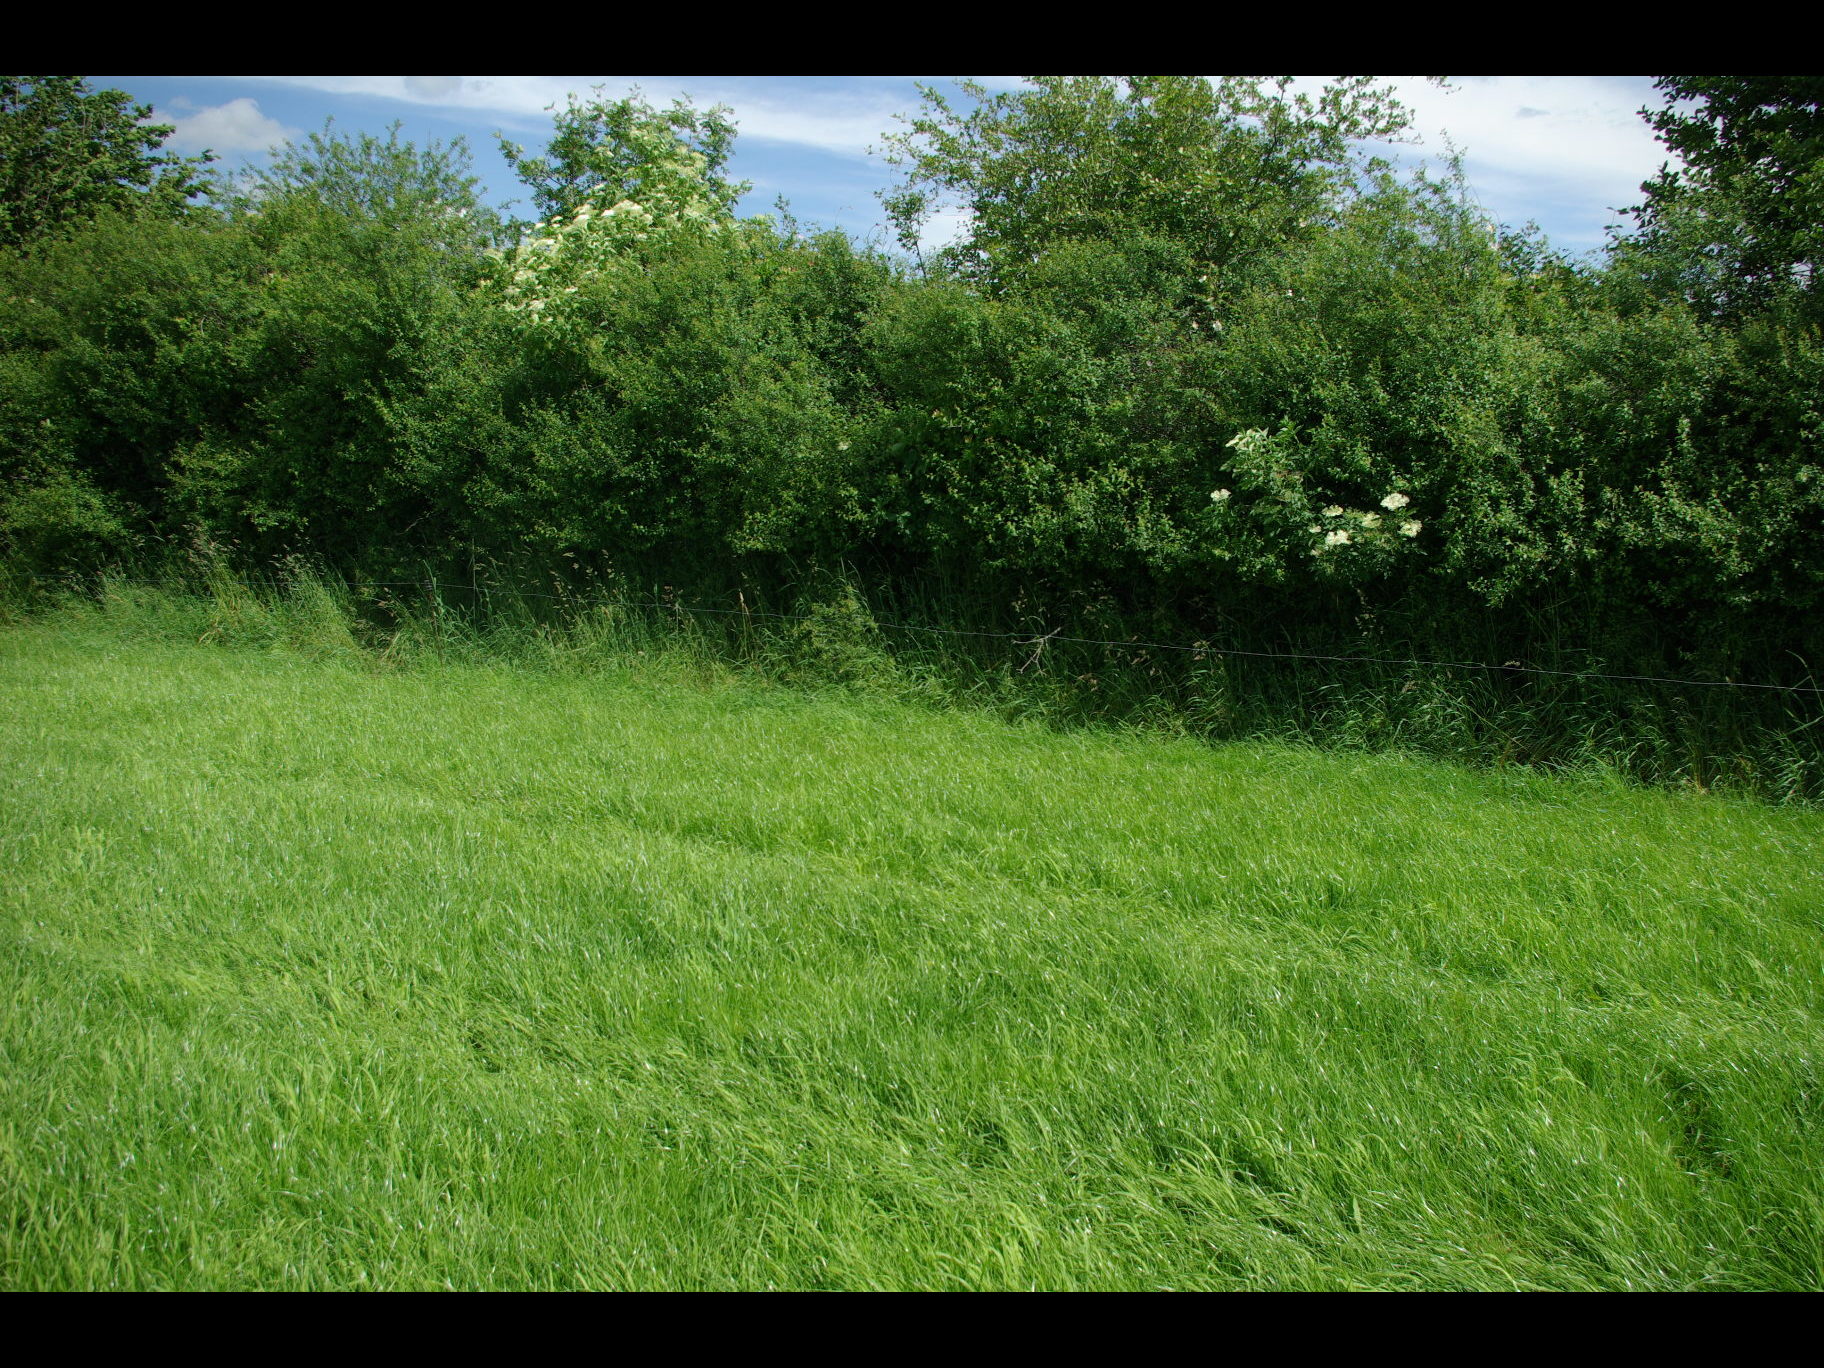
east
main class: Grassland
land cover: Grassland without tree/shrub cover
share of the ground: > 75 %
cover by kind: herbaceous plants 100 %
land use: Agriculture (excluding fallow land and kitchen gardens)
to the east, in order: Grassland without tree/shrub cover; Fences; Grass margins; Shrubland with sparse tree cover; Rape and turnip rape; Fences; Grassland without tree/shrub cover; Shruby margins; Fences; Spontaneously vegetated surfaces; Other structural elements; Paved roads, cycling and walking lanes; Grass margins; Broadleaved woodland; Fences; Grassland without tree/shrub cover
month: June
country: DE
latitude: 54.3899
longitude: 9.6460
